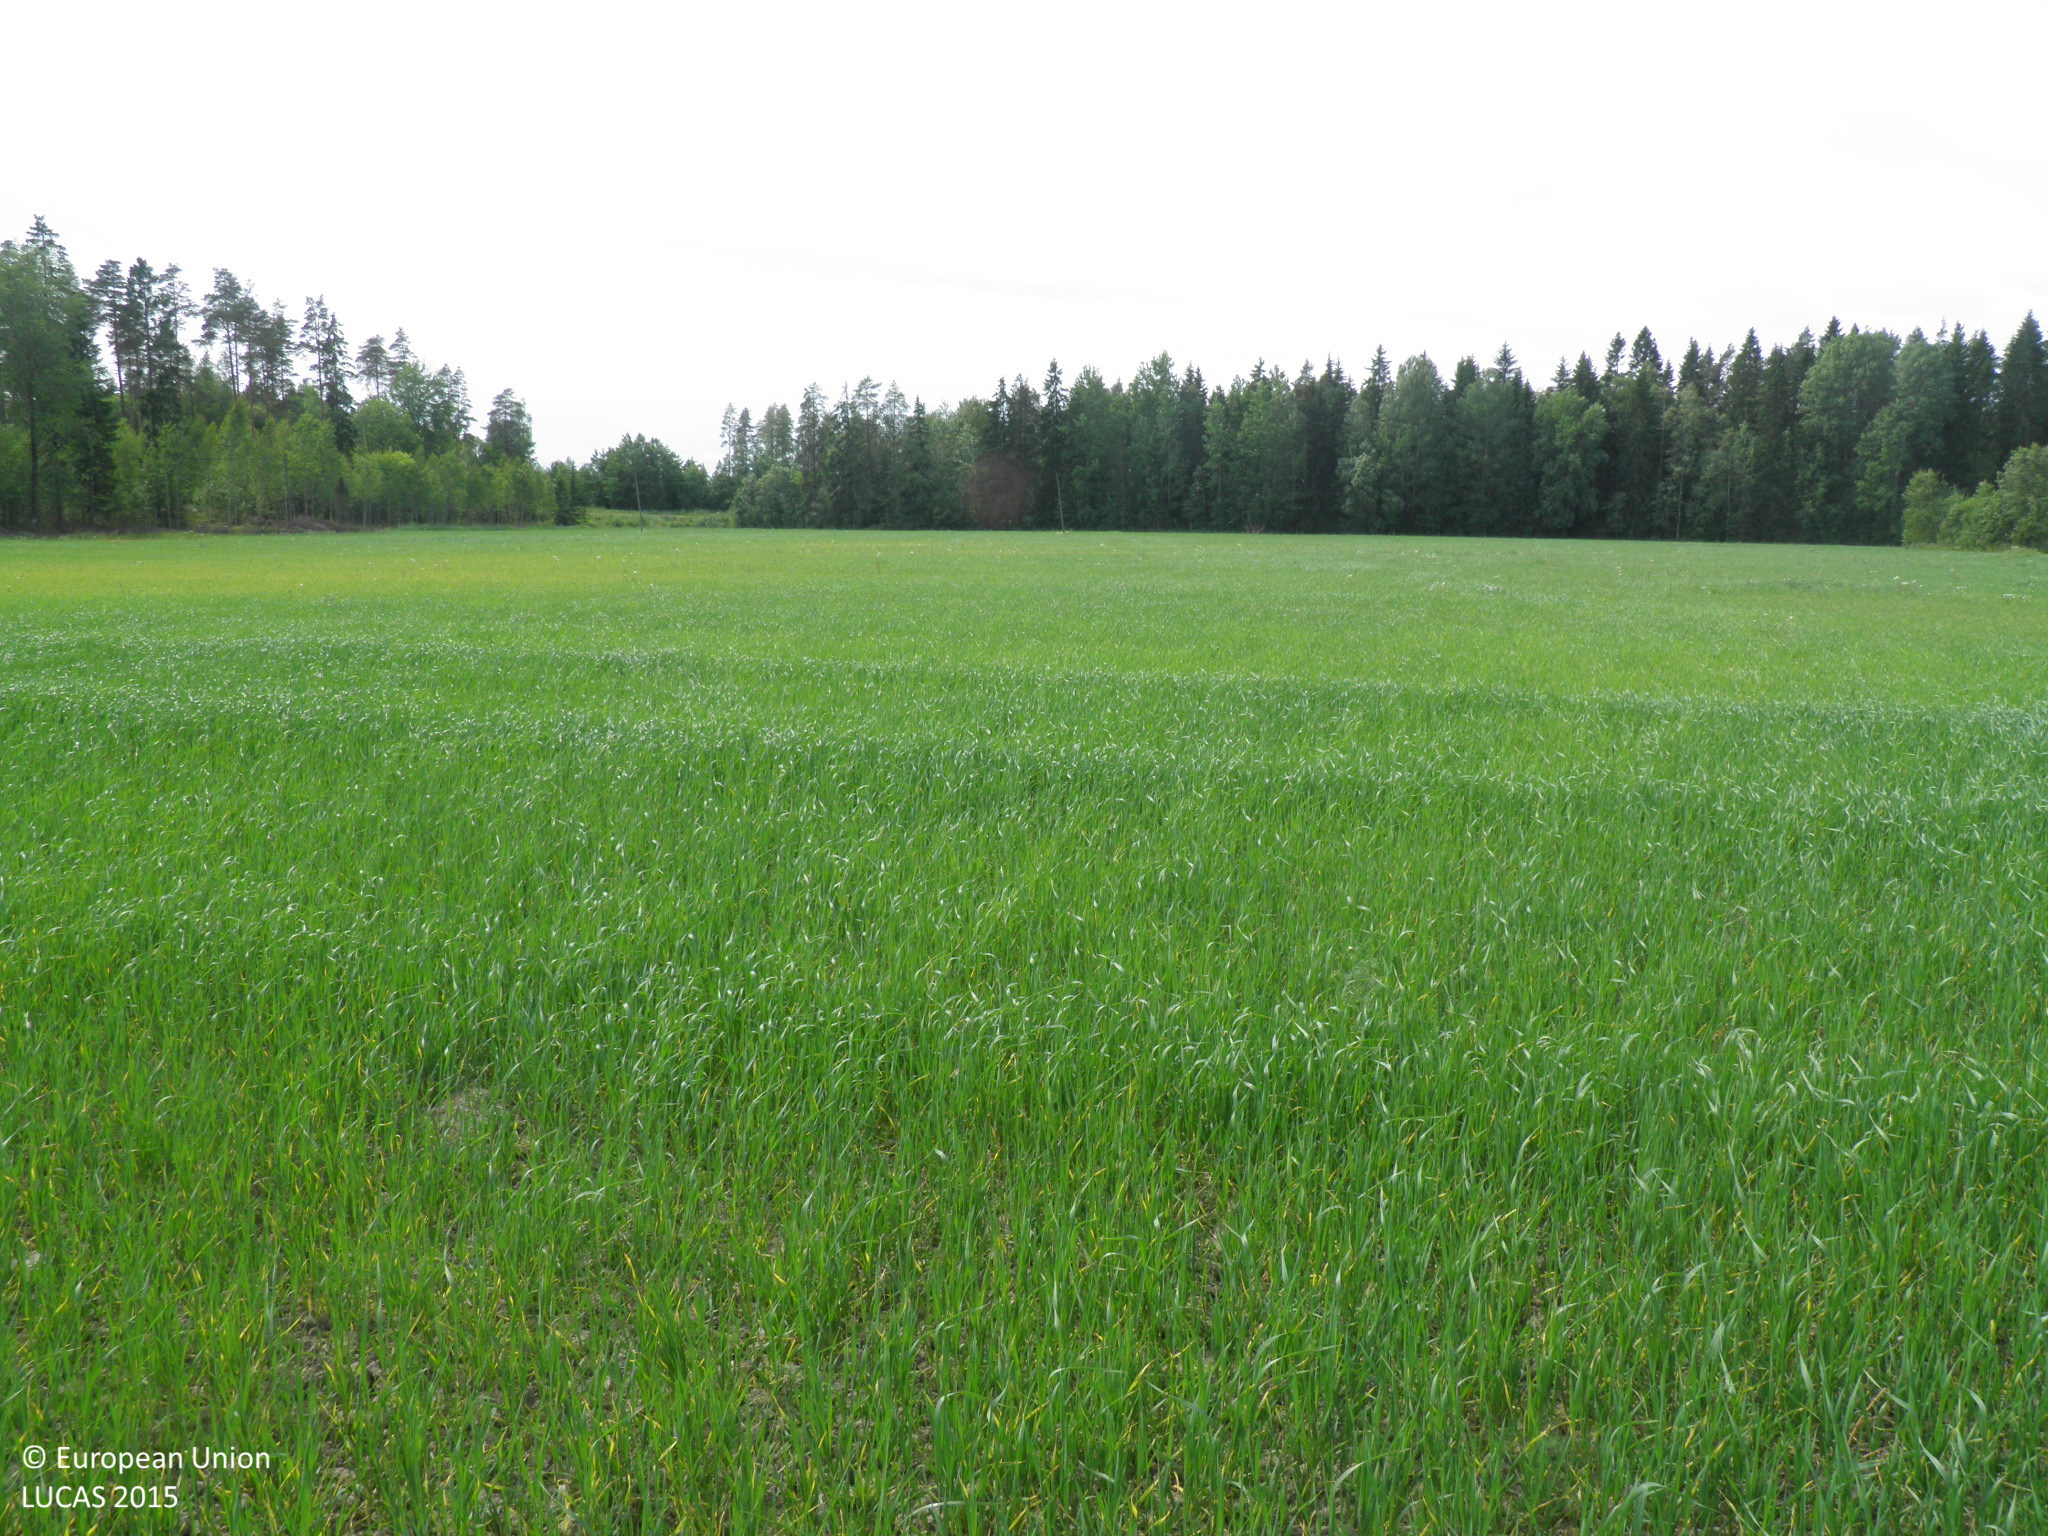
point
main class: Cropland
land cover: Common wheat
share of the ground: > 75 %
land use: Agriculture (excluding fallow land and kitchen gardens)
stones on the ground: < 10 %
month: July
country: FI
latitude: 60.7151
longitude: 22.7364
